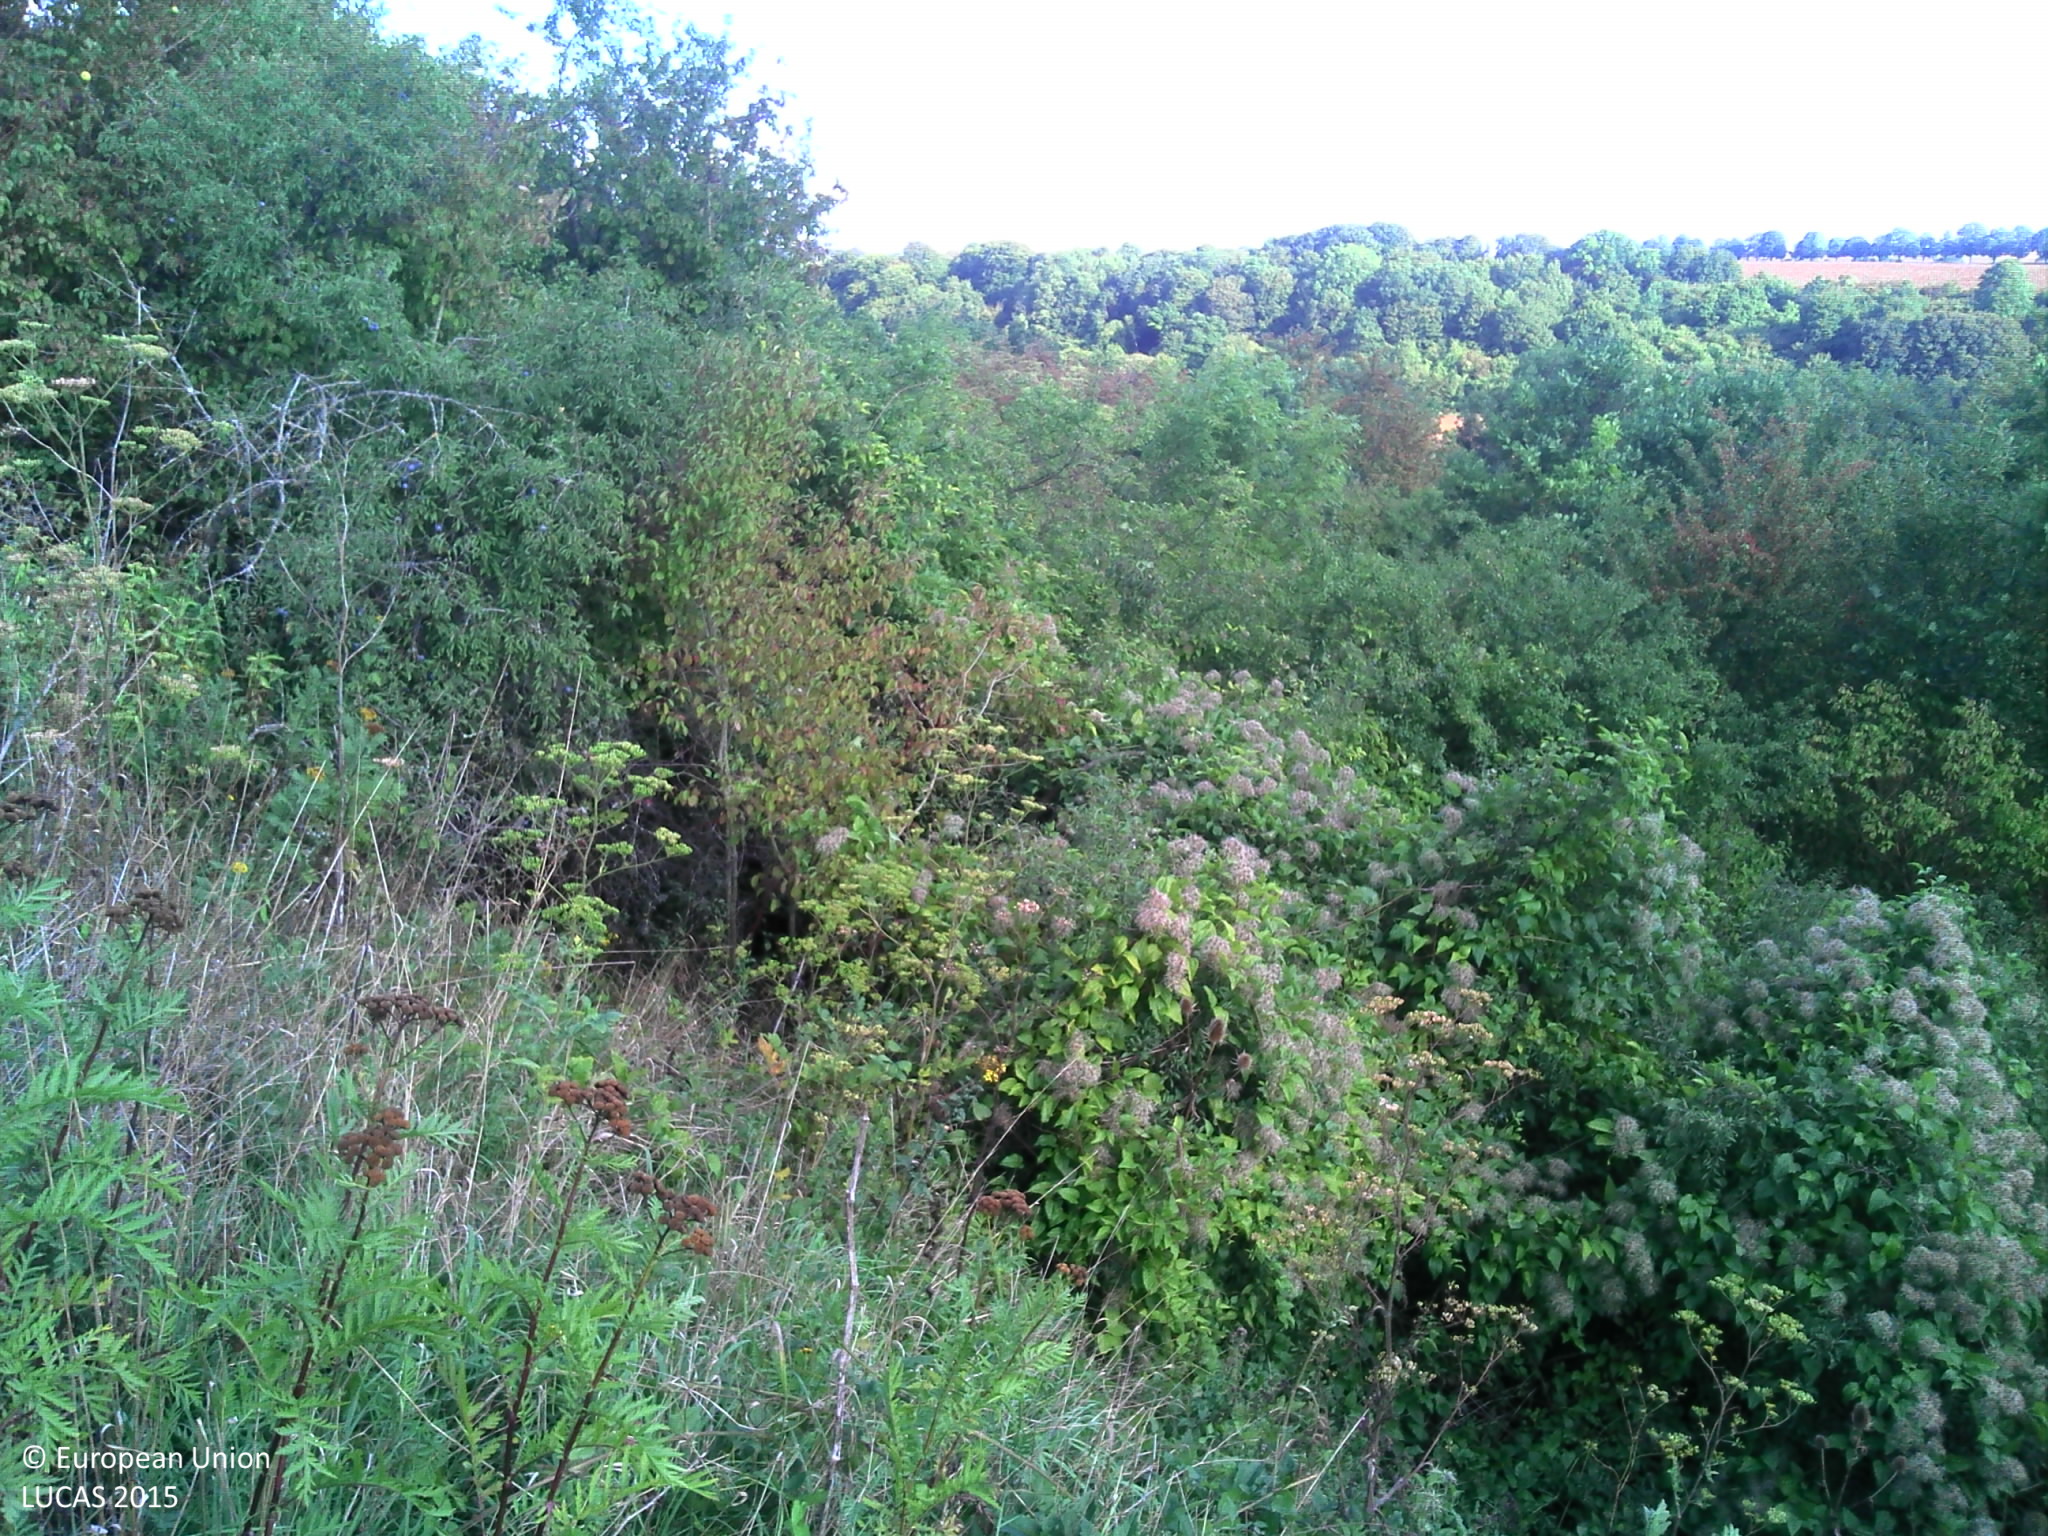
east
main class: Shrubland
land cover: Shrubland with sparse tree cover
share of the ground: > 75 %
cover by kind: shrubs 50 %, herbaceous plants 30 %, consolidated bare surface 15 %, broadleaved forest trees 5 %
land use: Semi-natural and natural areas not in use
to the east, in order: Shrubland with sparse tree cover; Shrubland without tree cover; Shrubland with sparse tree cover; Shrubland without tree cover; Tracks; Shruby margins; Fences; Grassland without tree/shrub cover; Shrubland without tree cover; Grassland without tree/shrub cover; Electric lines; Grassland without tree/shrub cover
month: September
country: FR
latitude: 49.2120
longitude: 5.9498
